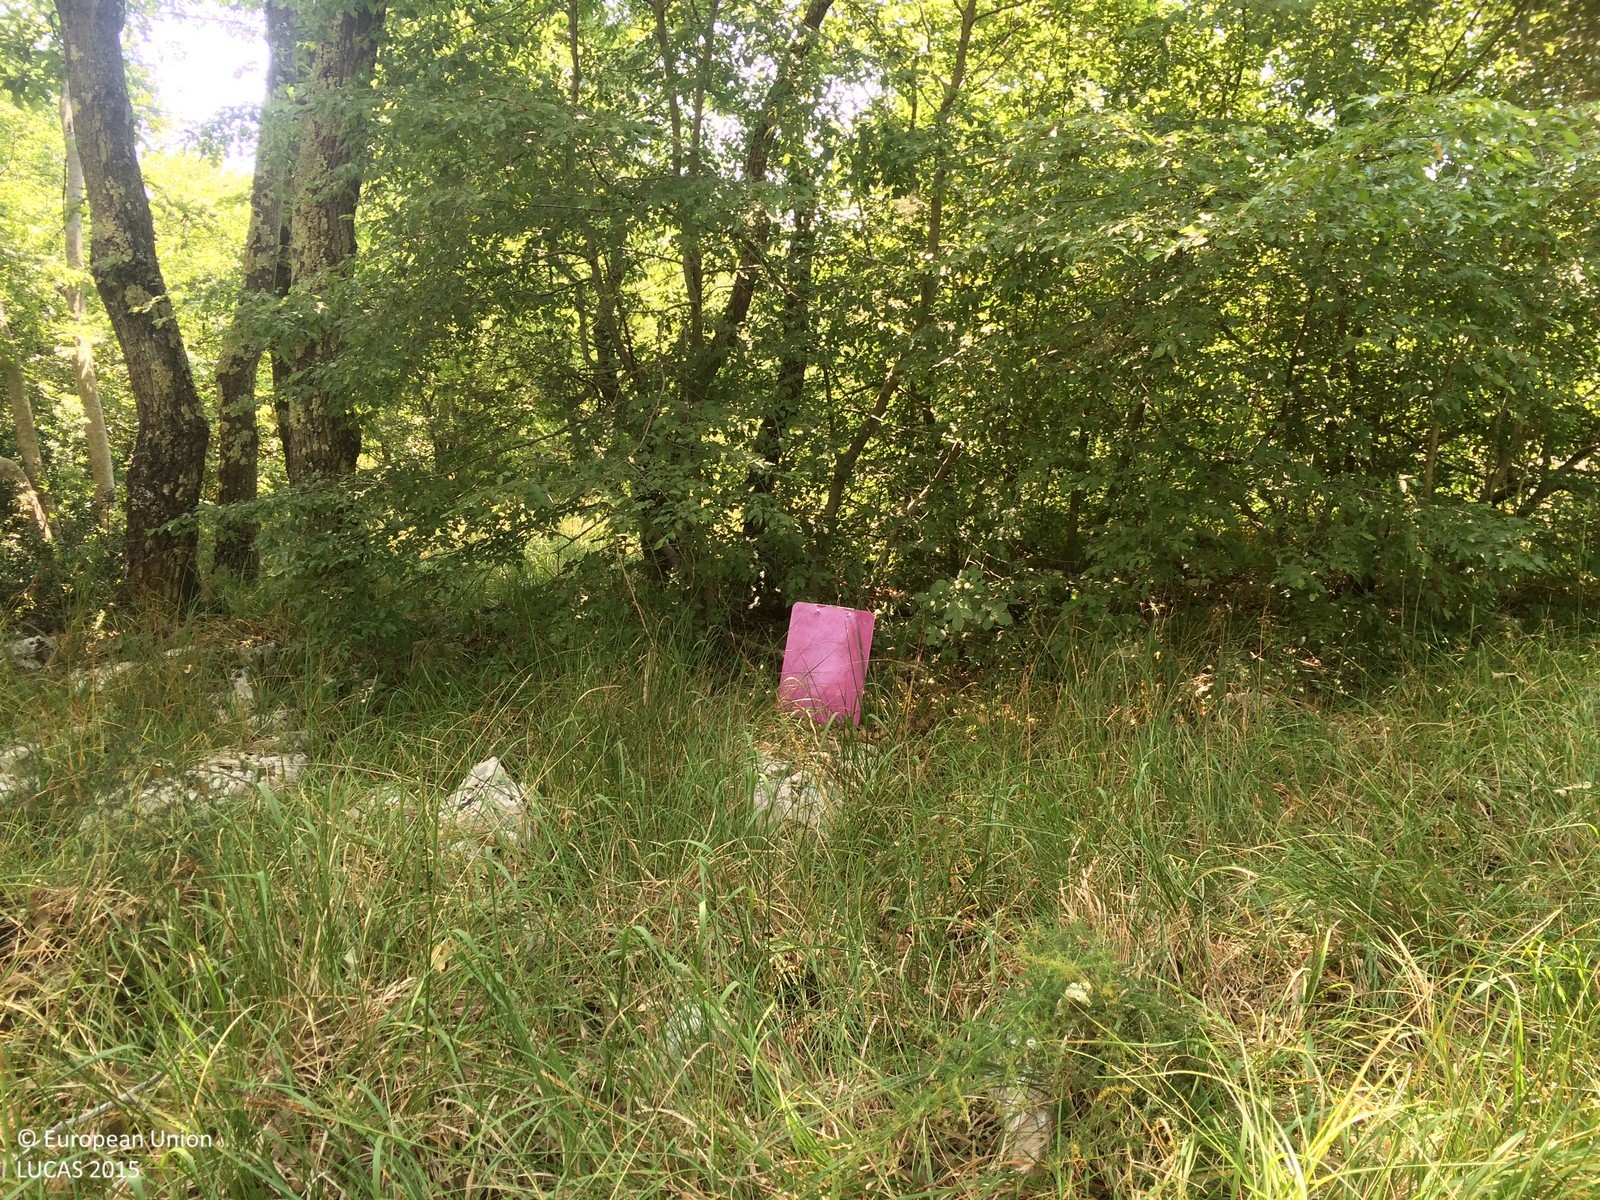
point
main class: Woodland
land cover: Broadleaved woodland
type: mesophytic deciduous forest
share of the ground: > 75 %
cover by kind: broadleaved forest trees 90 %, shrubs 5 %, herbaceous plants 5 %
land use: Semi-natural and natural areas not in use
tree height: > 5 m
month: June
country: HR
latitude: 45.0944
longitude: 13.7685
